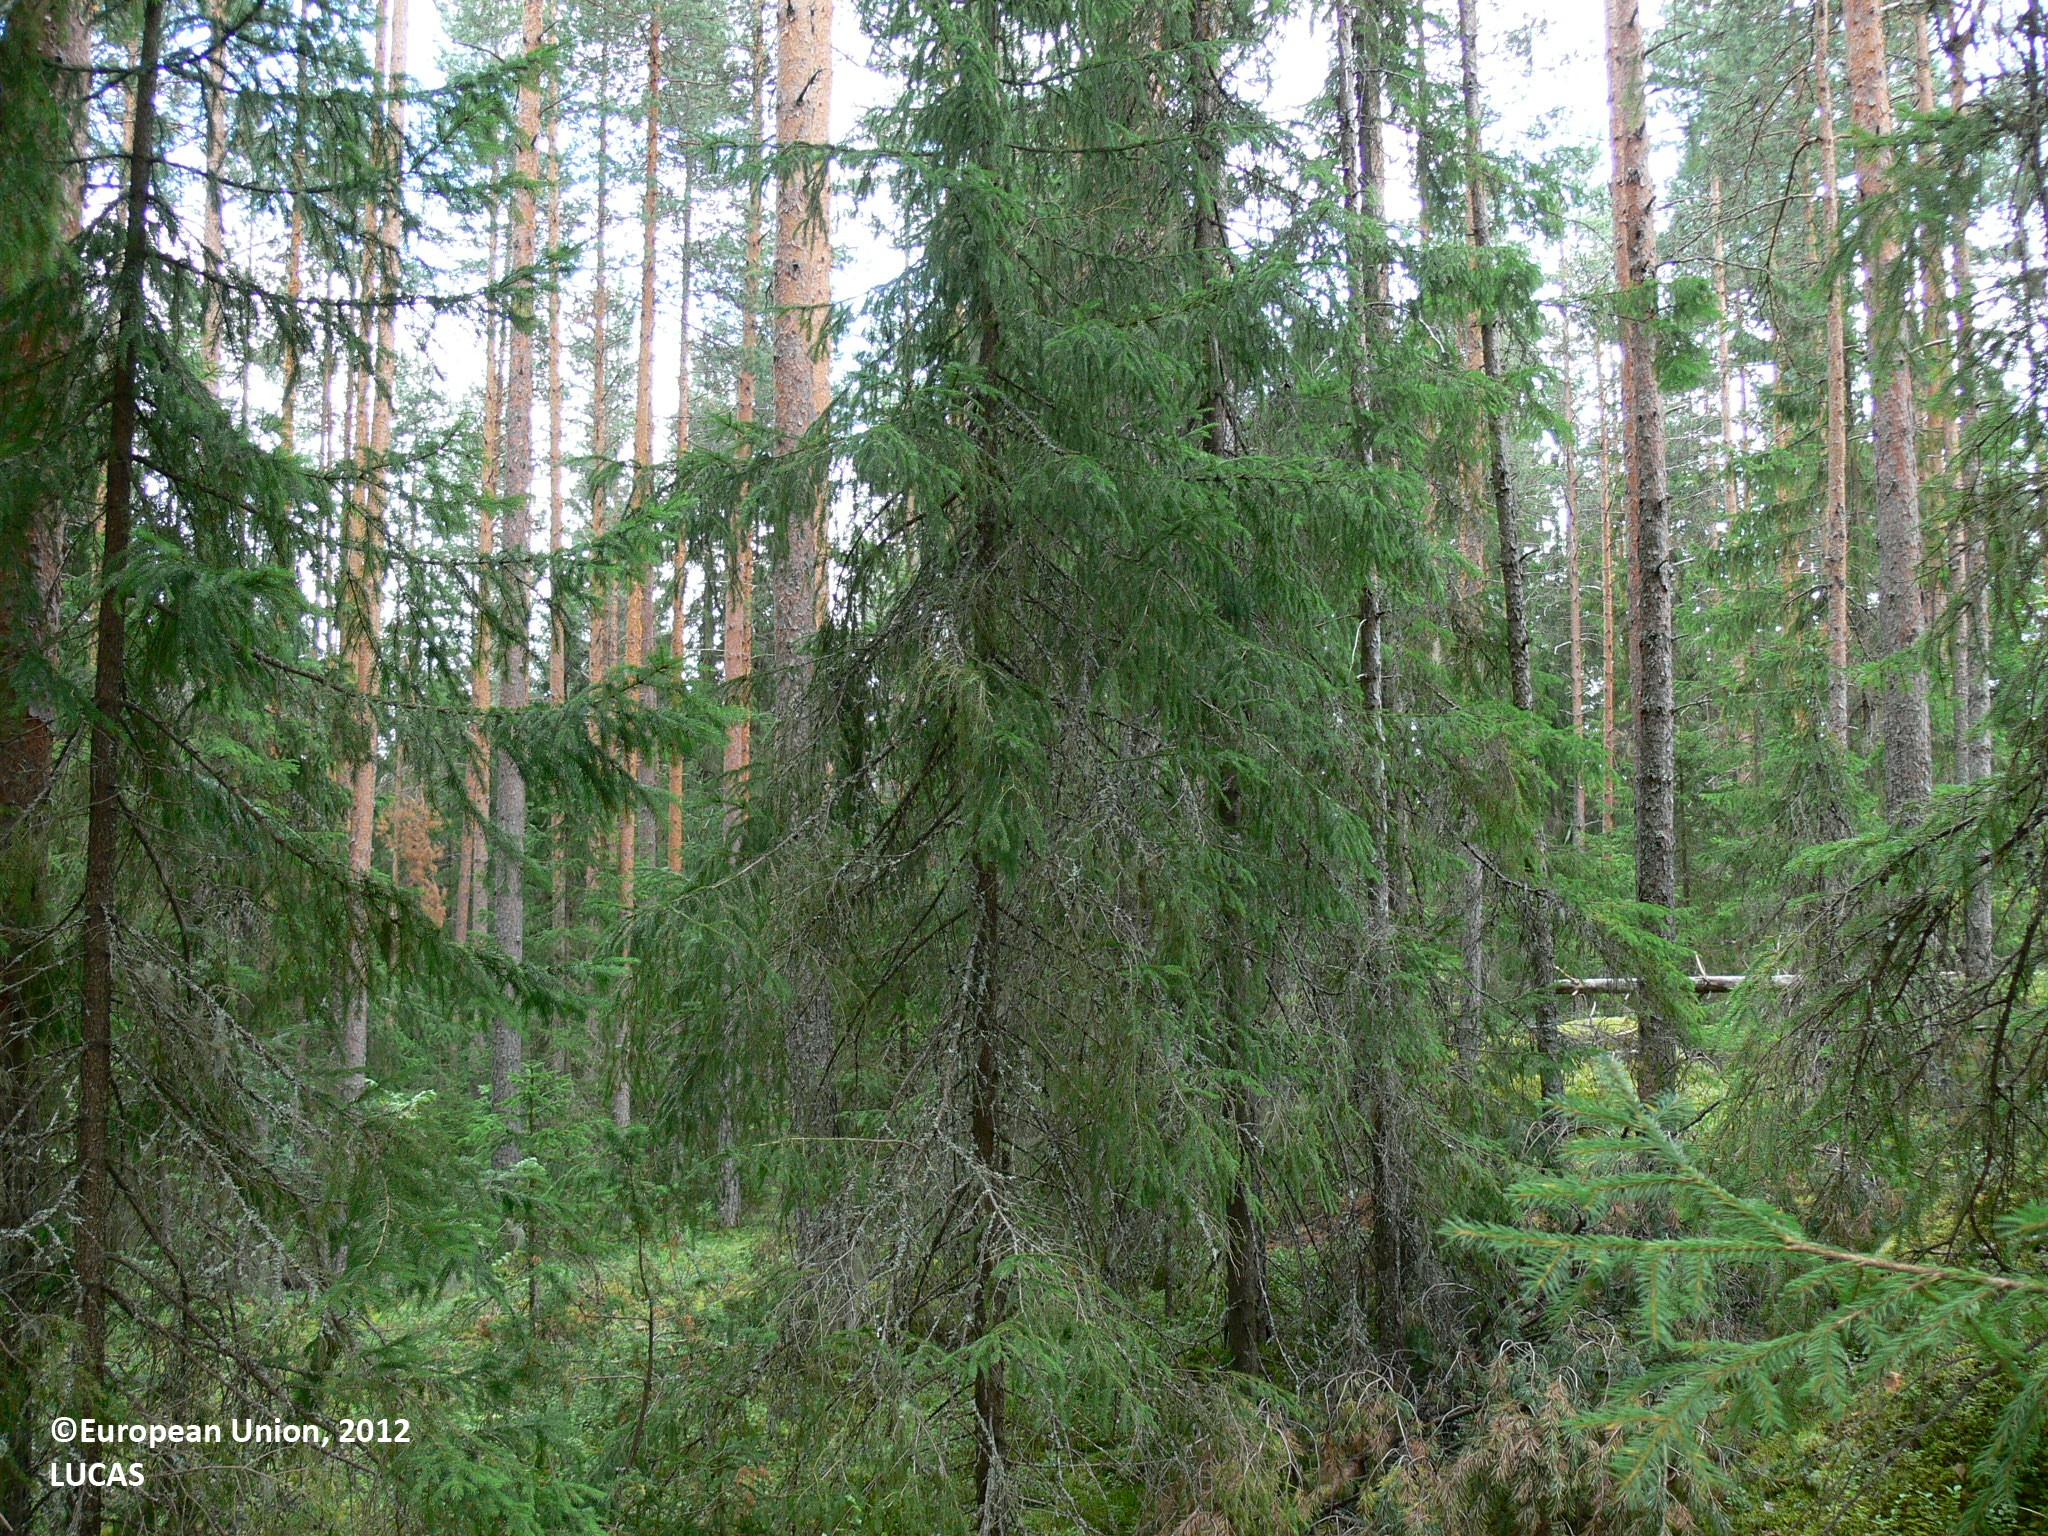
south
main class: Woodland
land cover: Other coniferous woodland
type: boreal forest
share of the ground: > 75 %
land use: Forestry
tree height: > 5 m
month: August
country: FI
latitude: 61.7320
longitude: 29.1821
